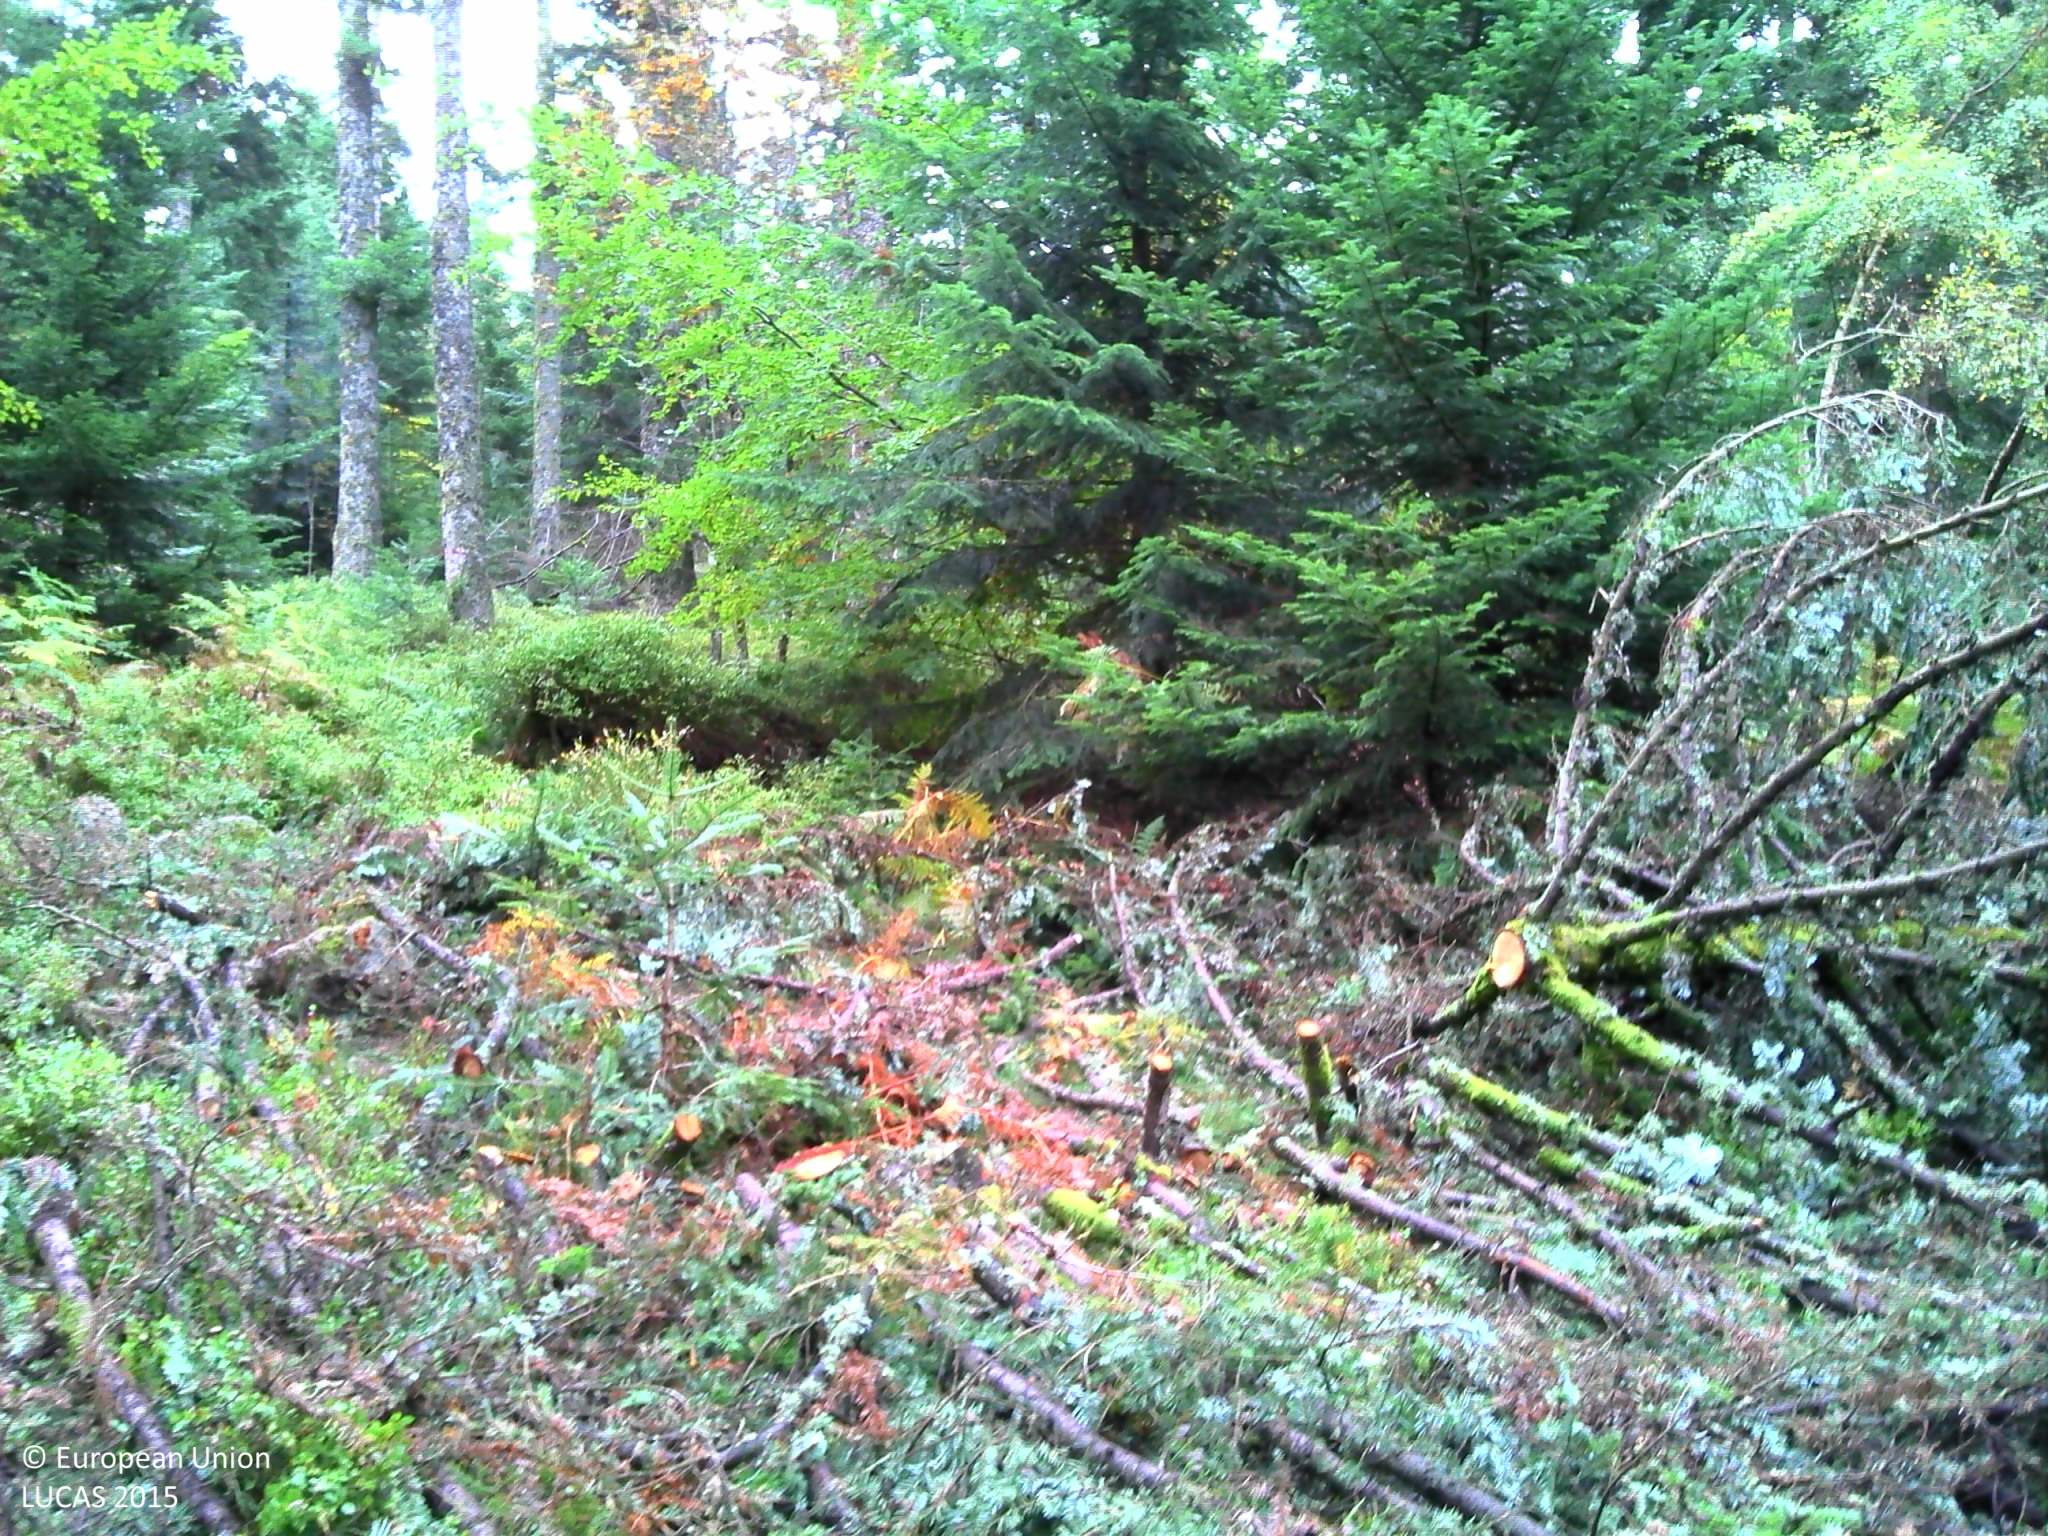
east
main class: Woodland
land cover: Other mixed woodland
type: alpine coniferous forest
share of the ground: 50 - 75 %
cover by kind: coniferous forest trees 45 %, shrubs 25 %, broadleaved forest trees 15 %, lichens and mosses 10 %, herbaceous plants 5 %
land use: Forestry
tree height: > 5 m
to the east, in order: Other mixed woodland; Tracks; Other mixed woodland; Tracks; Grass margins; Other mixed woodland; Grass margins; Tracks; Grass margins; Ditches and canals; Spontaneously vegetated surfaces; Spruce dominated coniferous woodland; Other mixed woodland
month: October
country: FR
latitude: 45.9467
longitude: 3.6670
